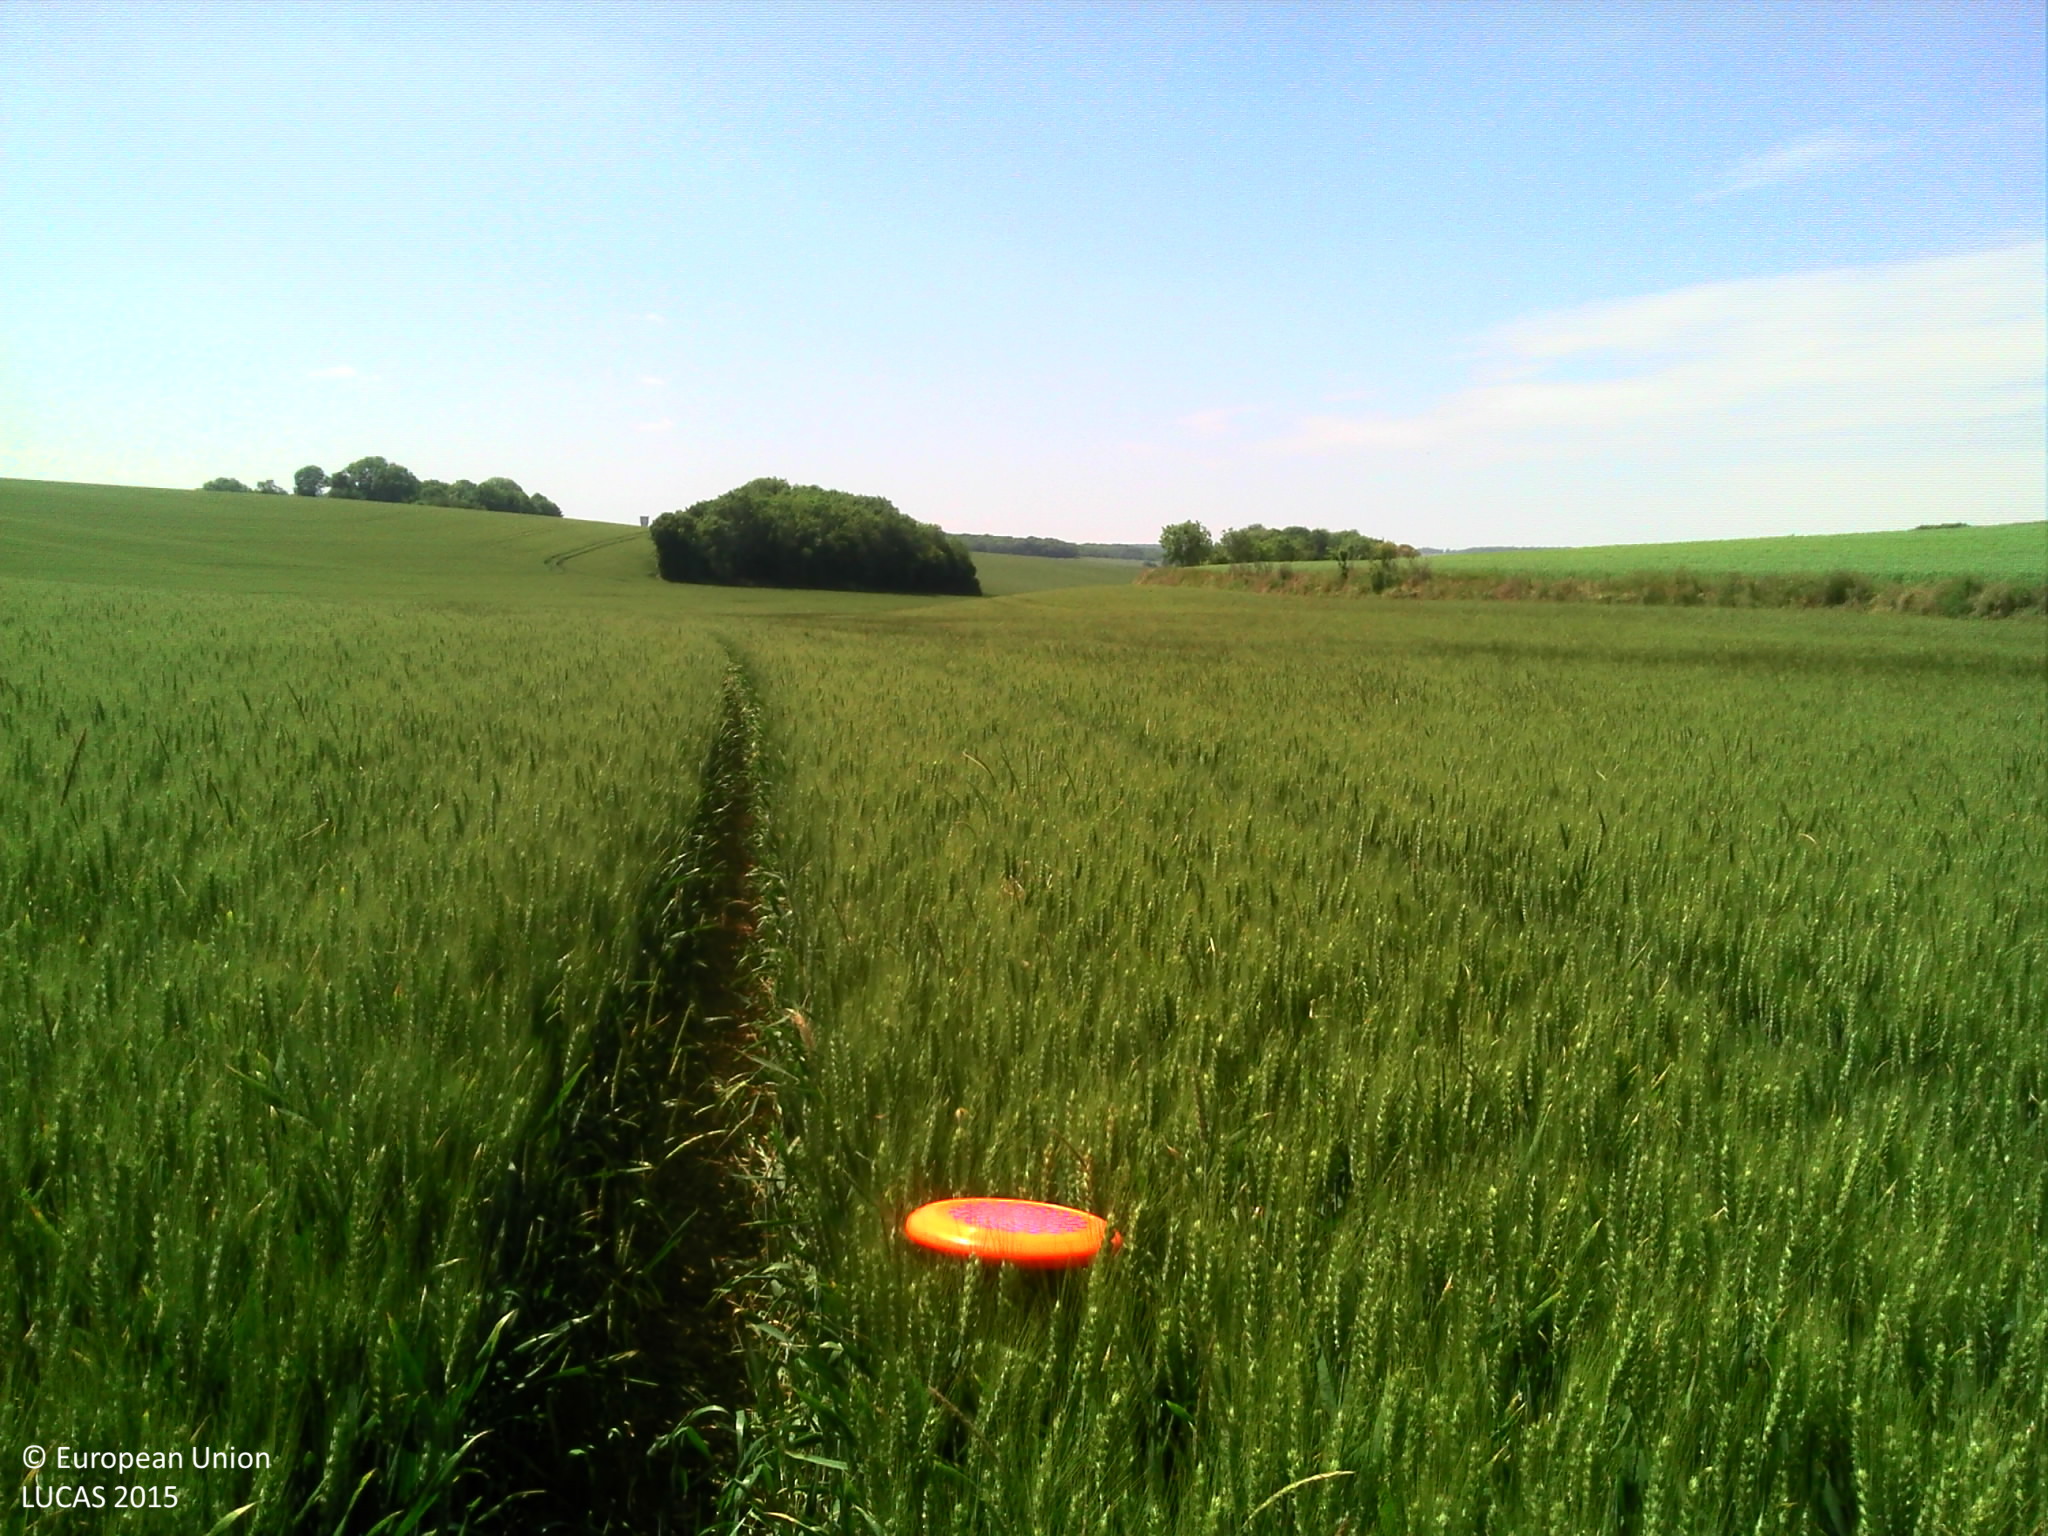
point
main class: Cropland
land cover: Common wheat
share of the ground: > 75 %
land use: Agriculture (excluding fallow land and kitchen gardens)
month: June
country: FR
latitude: 49.7118
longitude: 2.3735
